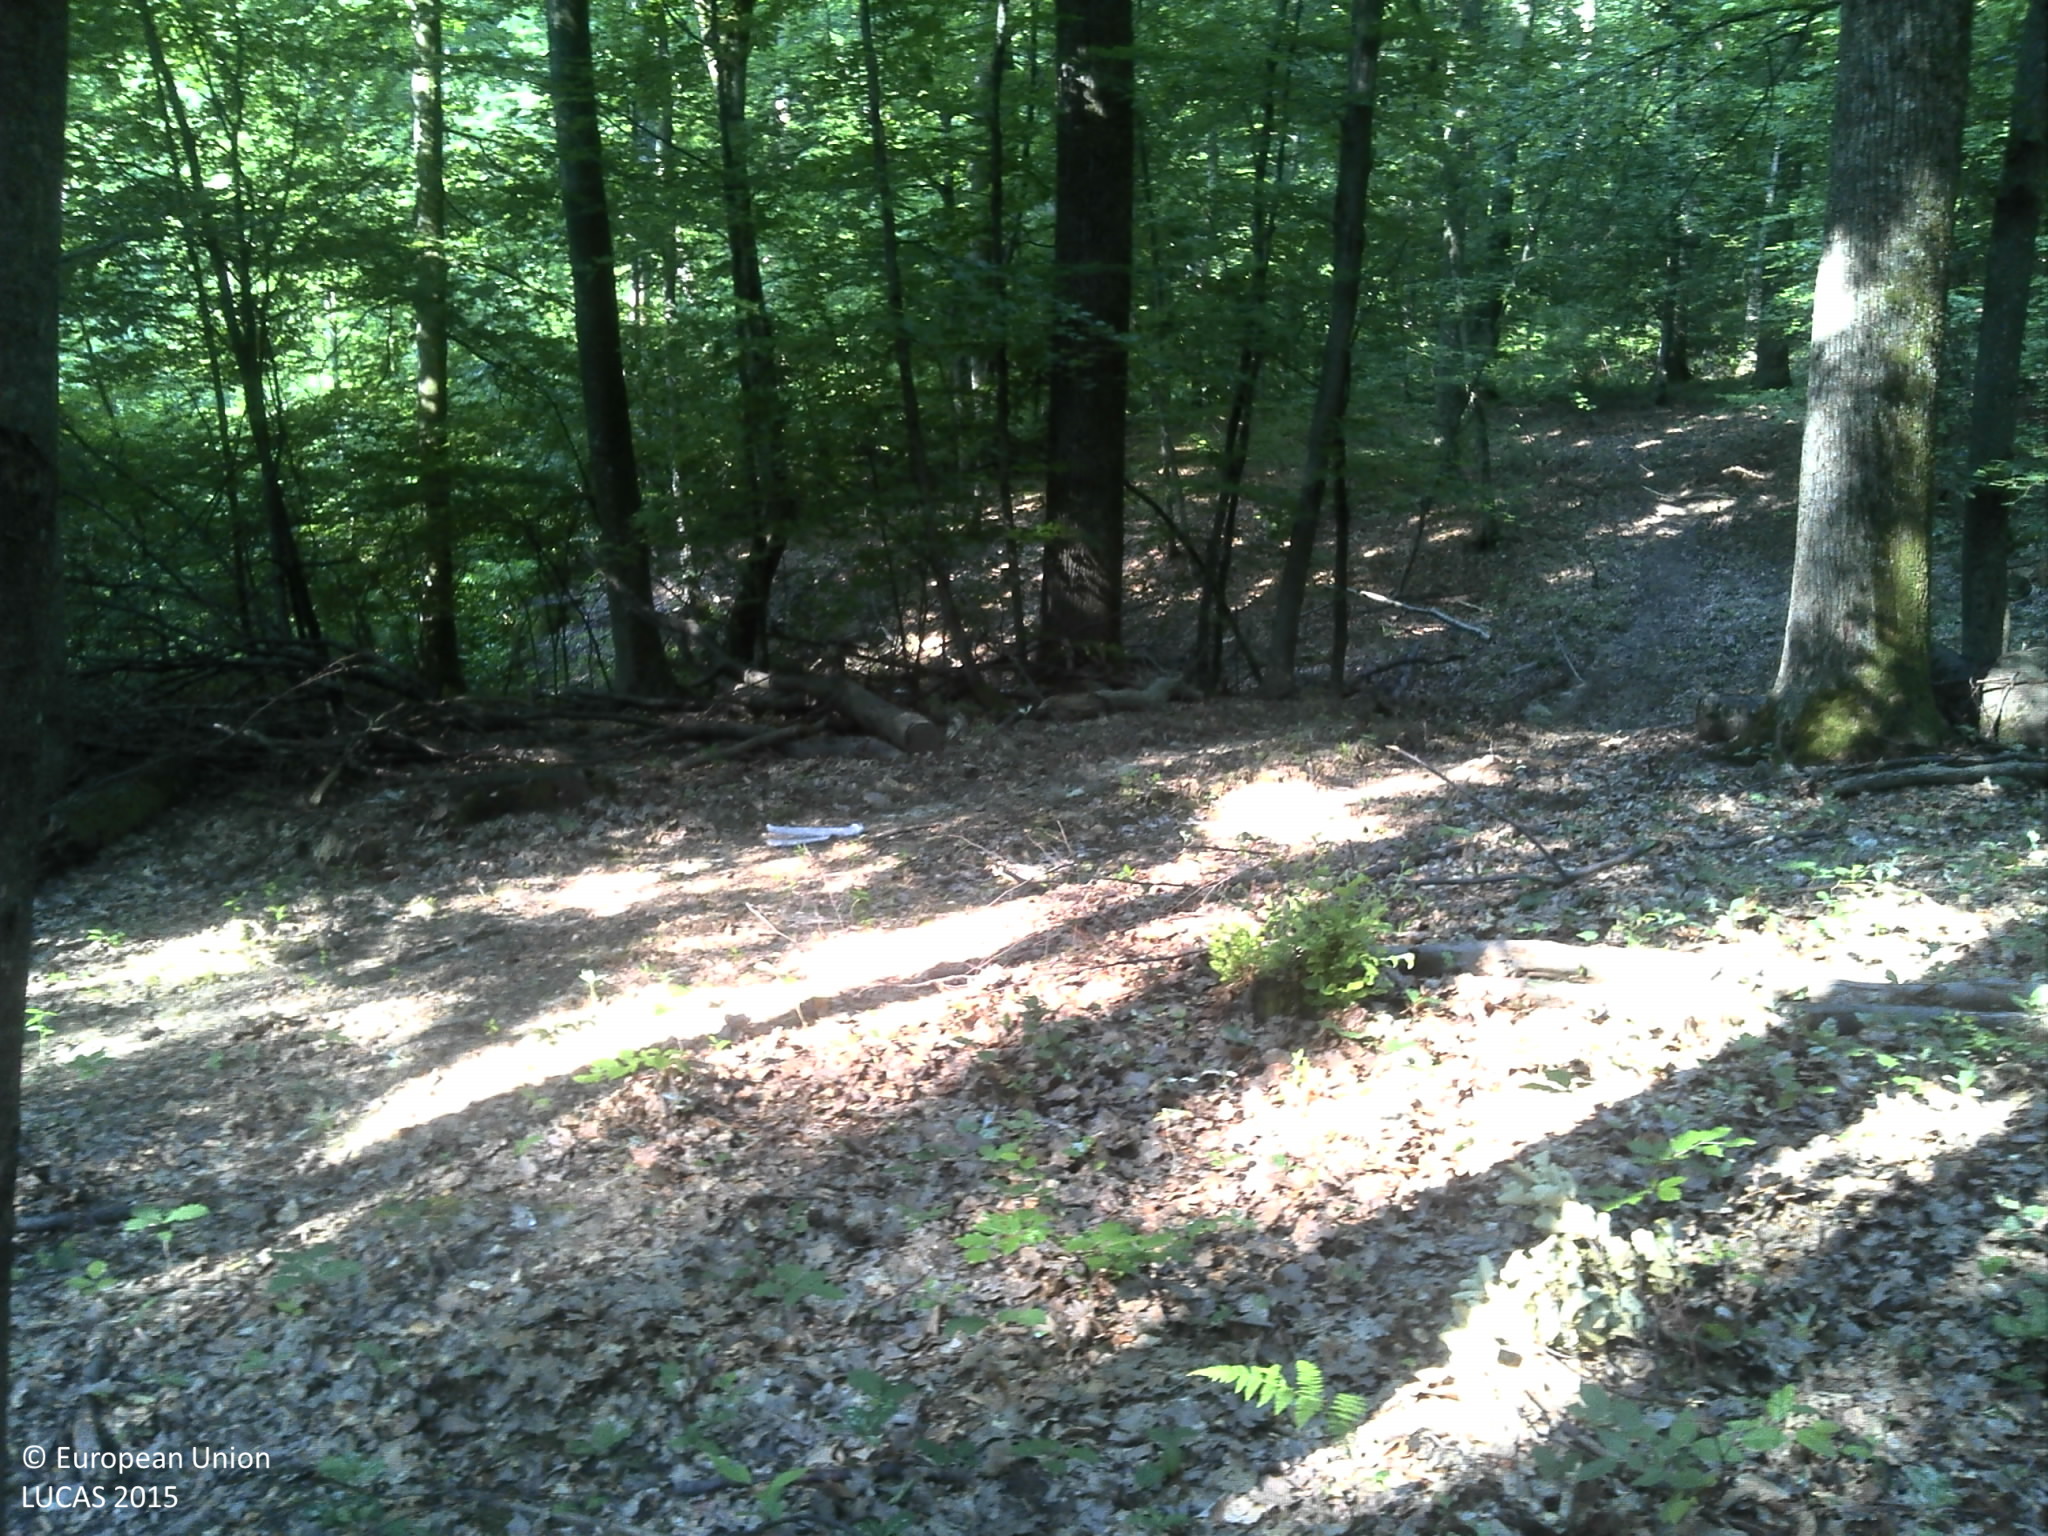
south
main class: Woodland
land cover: Broadleaved woodland
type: acidophilous oak and oak-birch forest
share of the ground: > 75 %
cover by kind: broadleaved forest trees 100 %
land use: Forestry
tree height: > 5 m
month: June
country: HR
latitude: 45.5336
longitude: 17.9043
